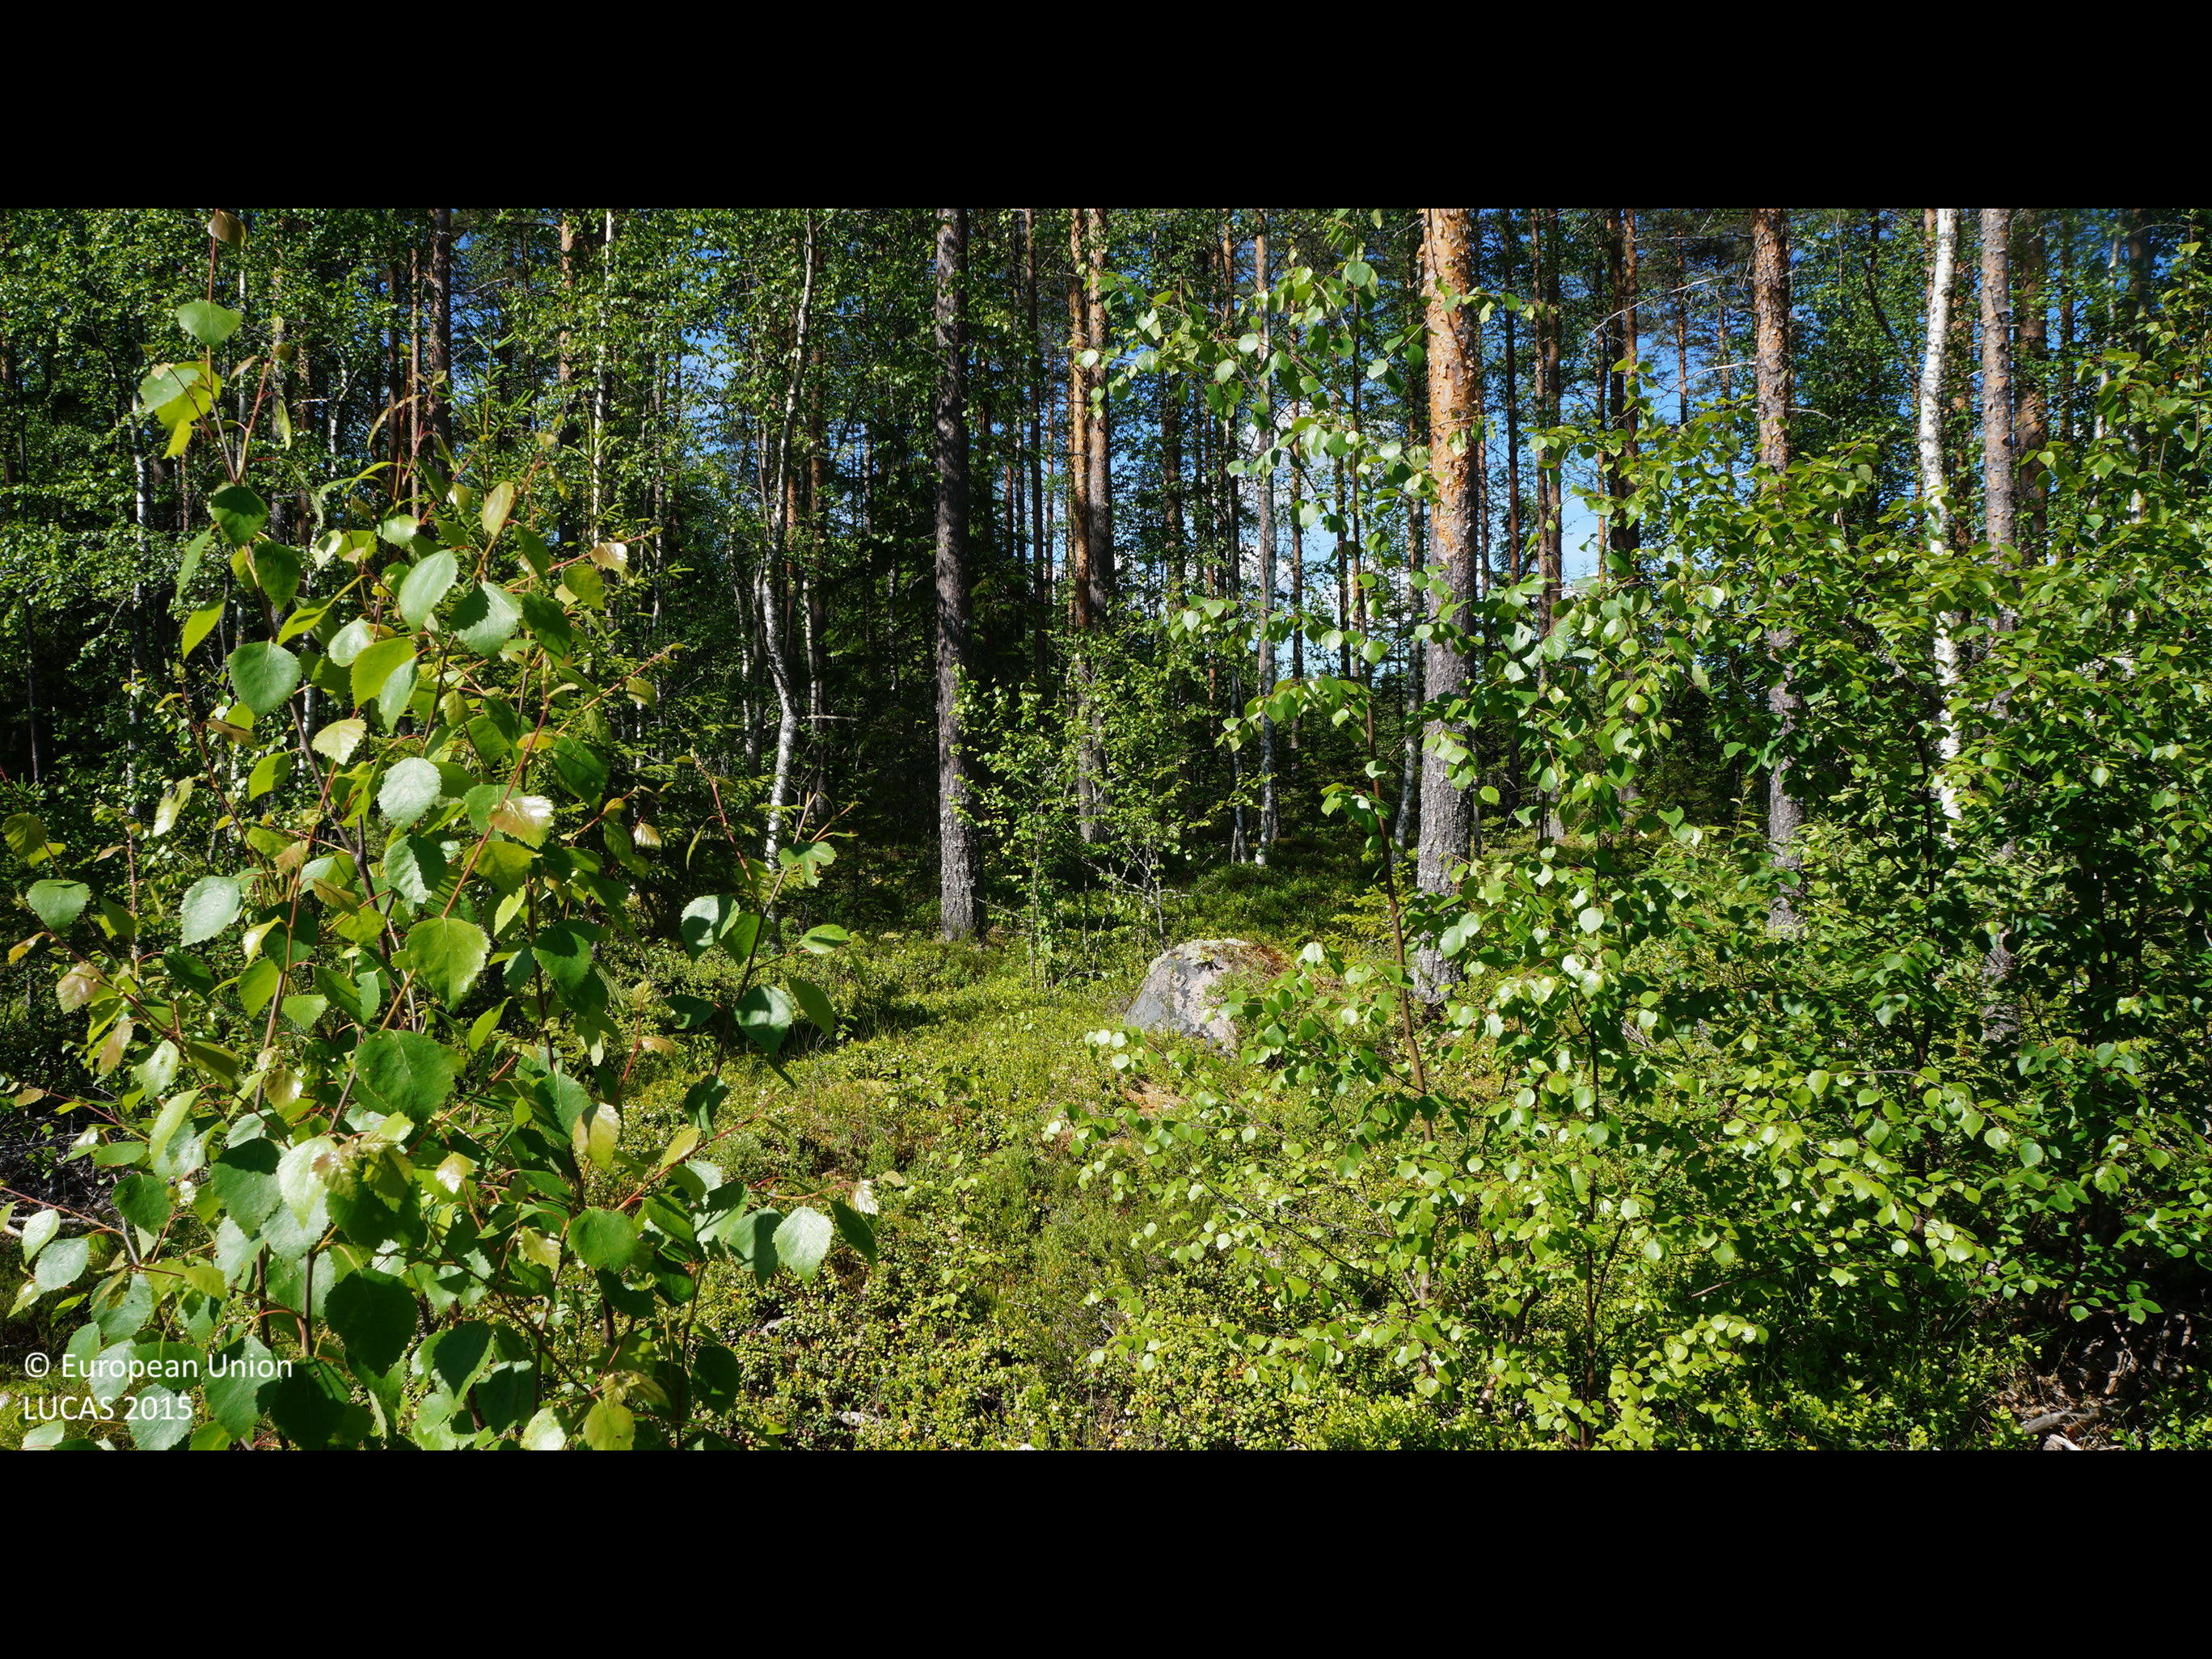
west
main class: Woodland
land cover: Broadleaved woodland
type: boreal forest
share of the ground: 50 - 75 %
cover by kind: broadleaved forest trees 40 %, shrubs 40 %, coniferous forest trees 10 %, herbaceous plants 5 %, unconsolidated bare surface 5 %
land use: Forestry
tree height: < 5 m
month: July
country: FI
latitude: 64.1516
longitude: 24.6930
